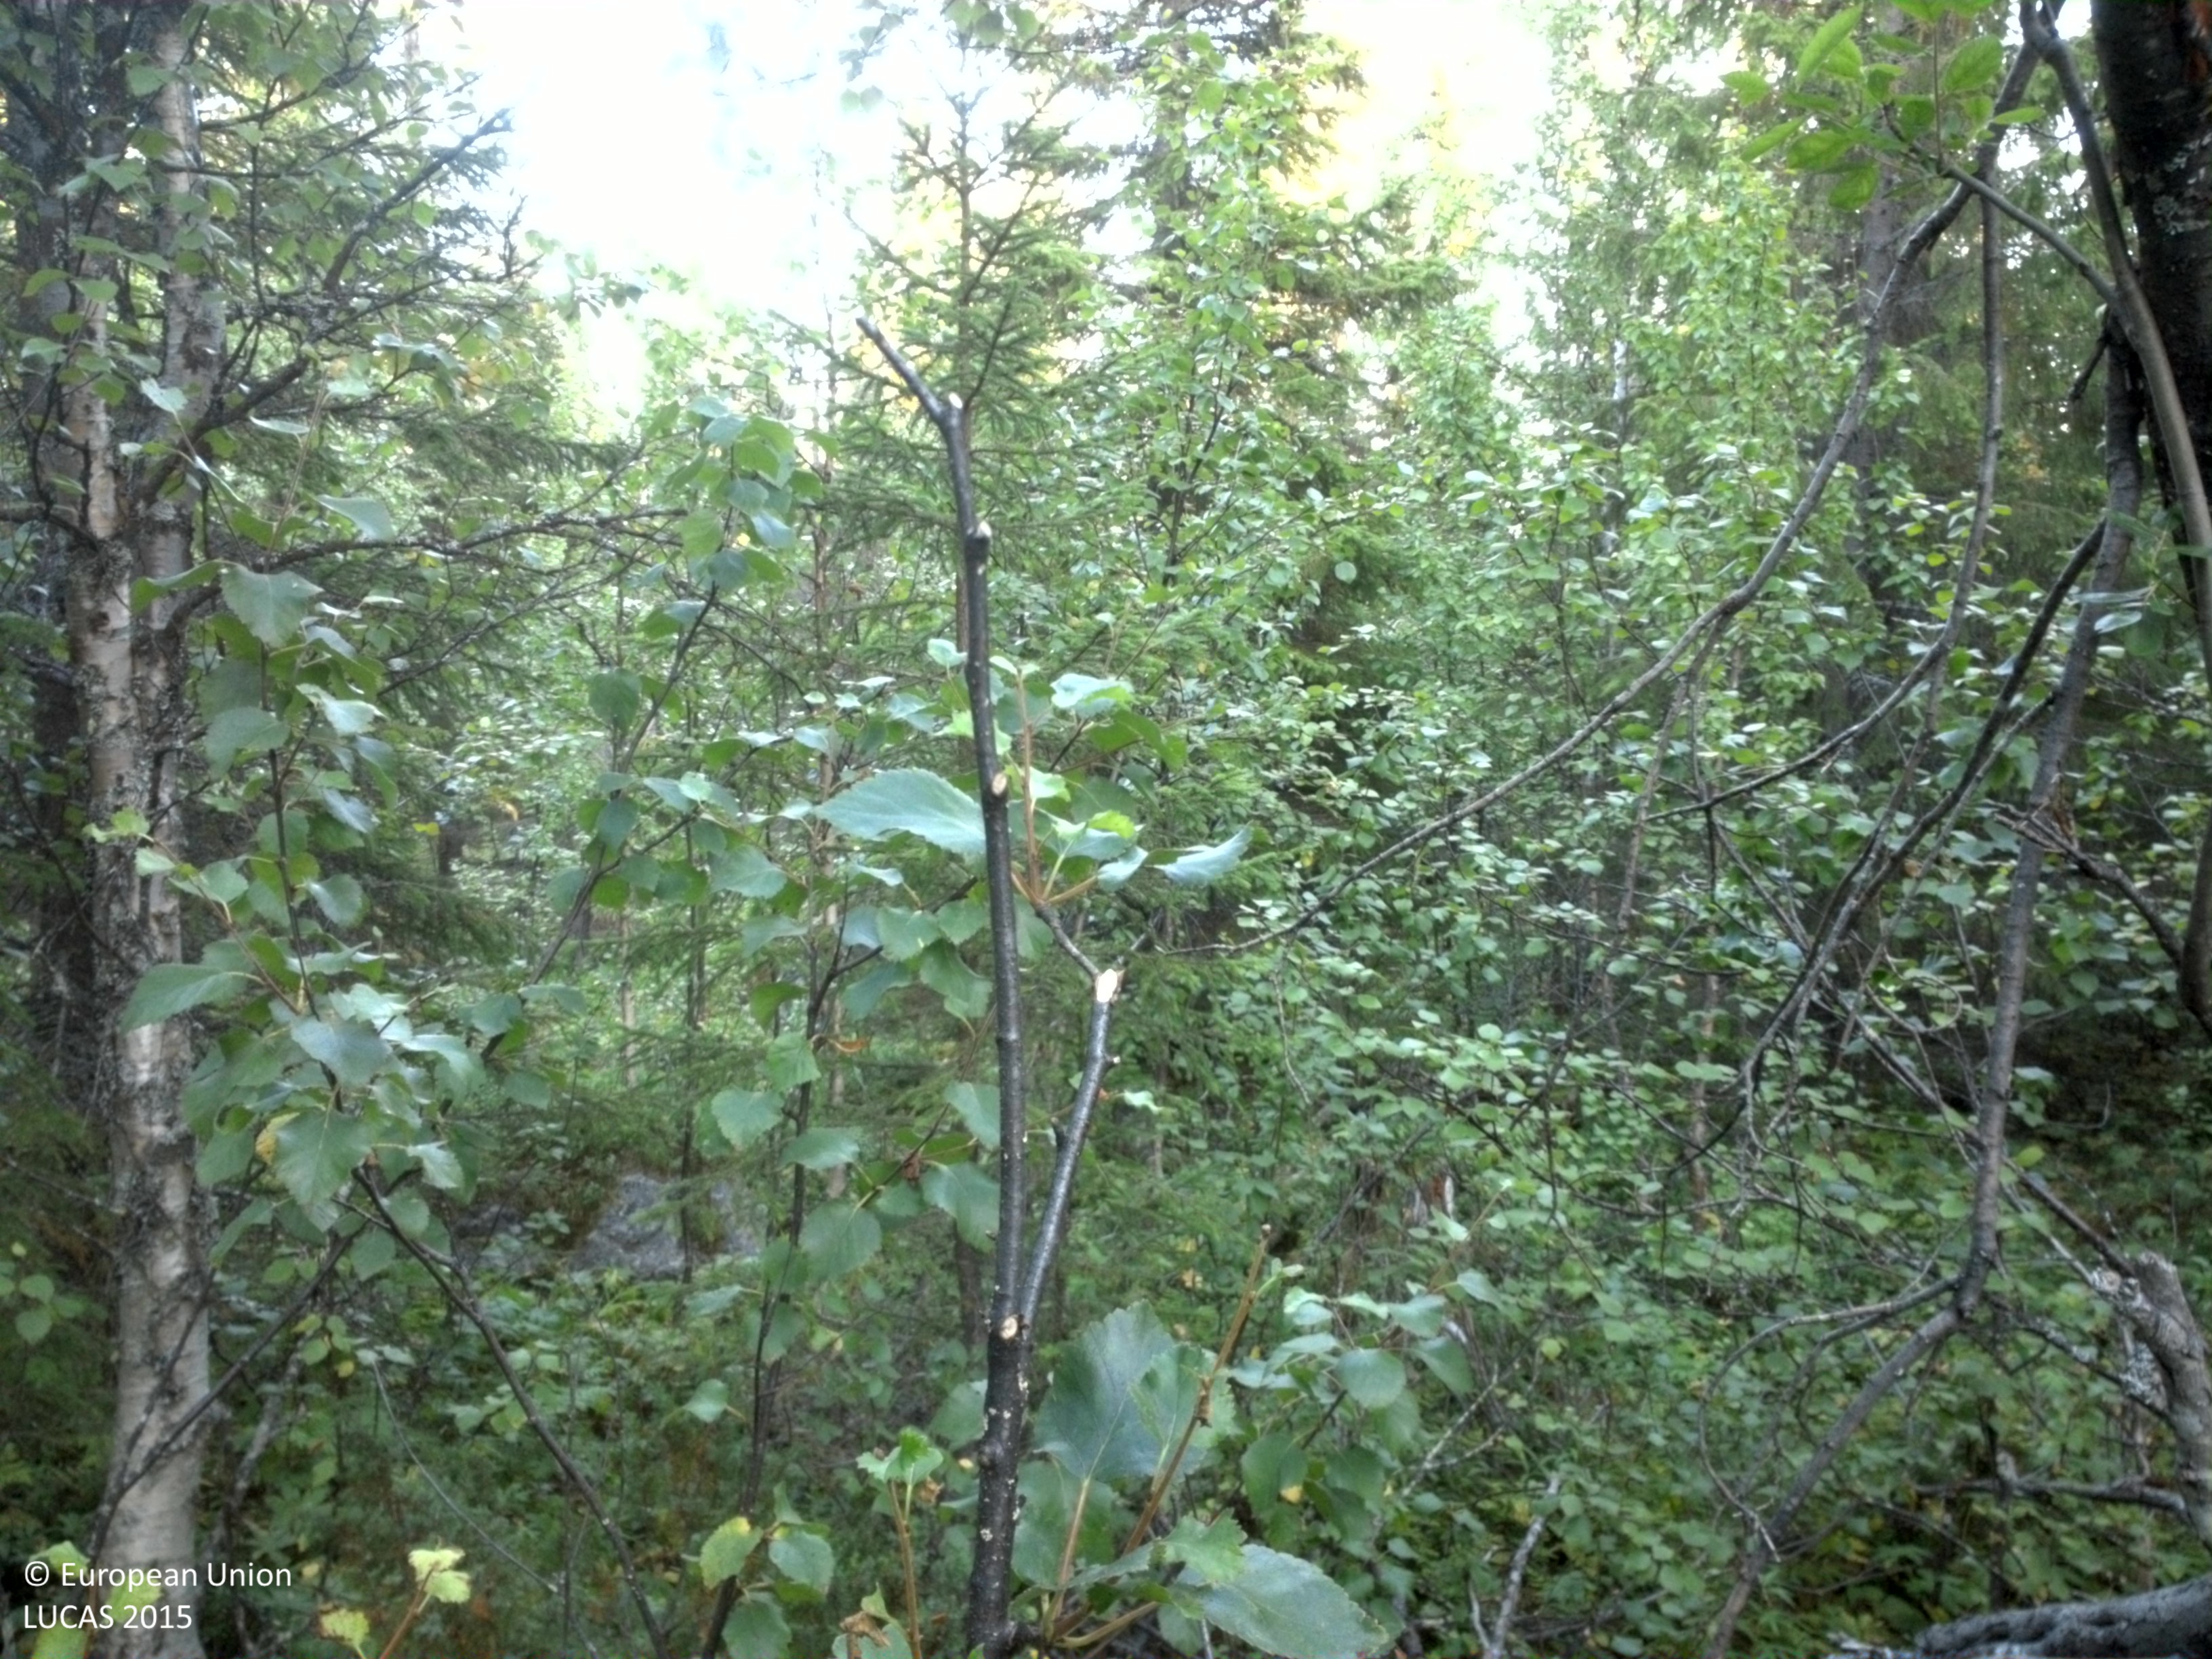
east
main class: Woodland
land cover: Spruce dominated mixed woodland
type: boreal forest
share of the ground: 50 - 75 %
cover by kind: broadleaved forest trees 40 %, coniferous forest trees 30 %, shrubs 15 %, herbaceous plants 15 %
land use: Forestry
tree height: > 5 m
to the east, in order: Spruce dominated mixed woodland
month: September
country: SE
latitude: 65.1825
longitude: 16.2204
